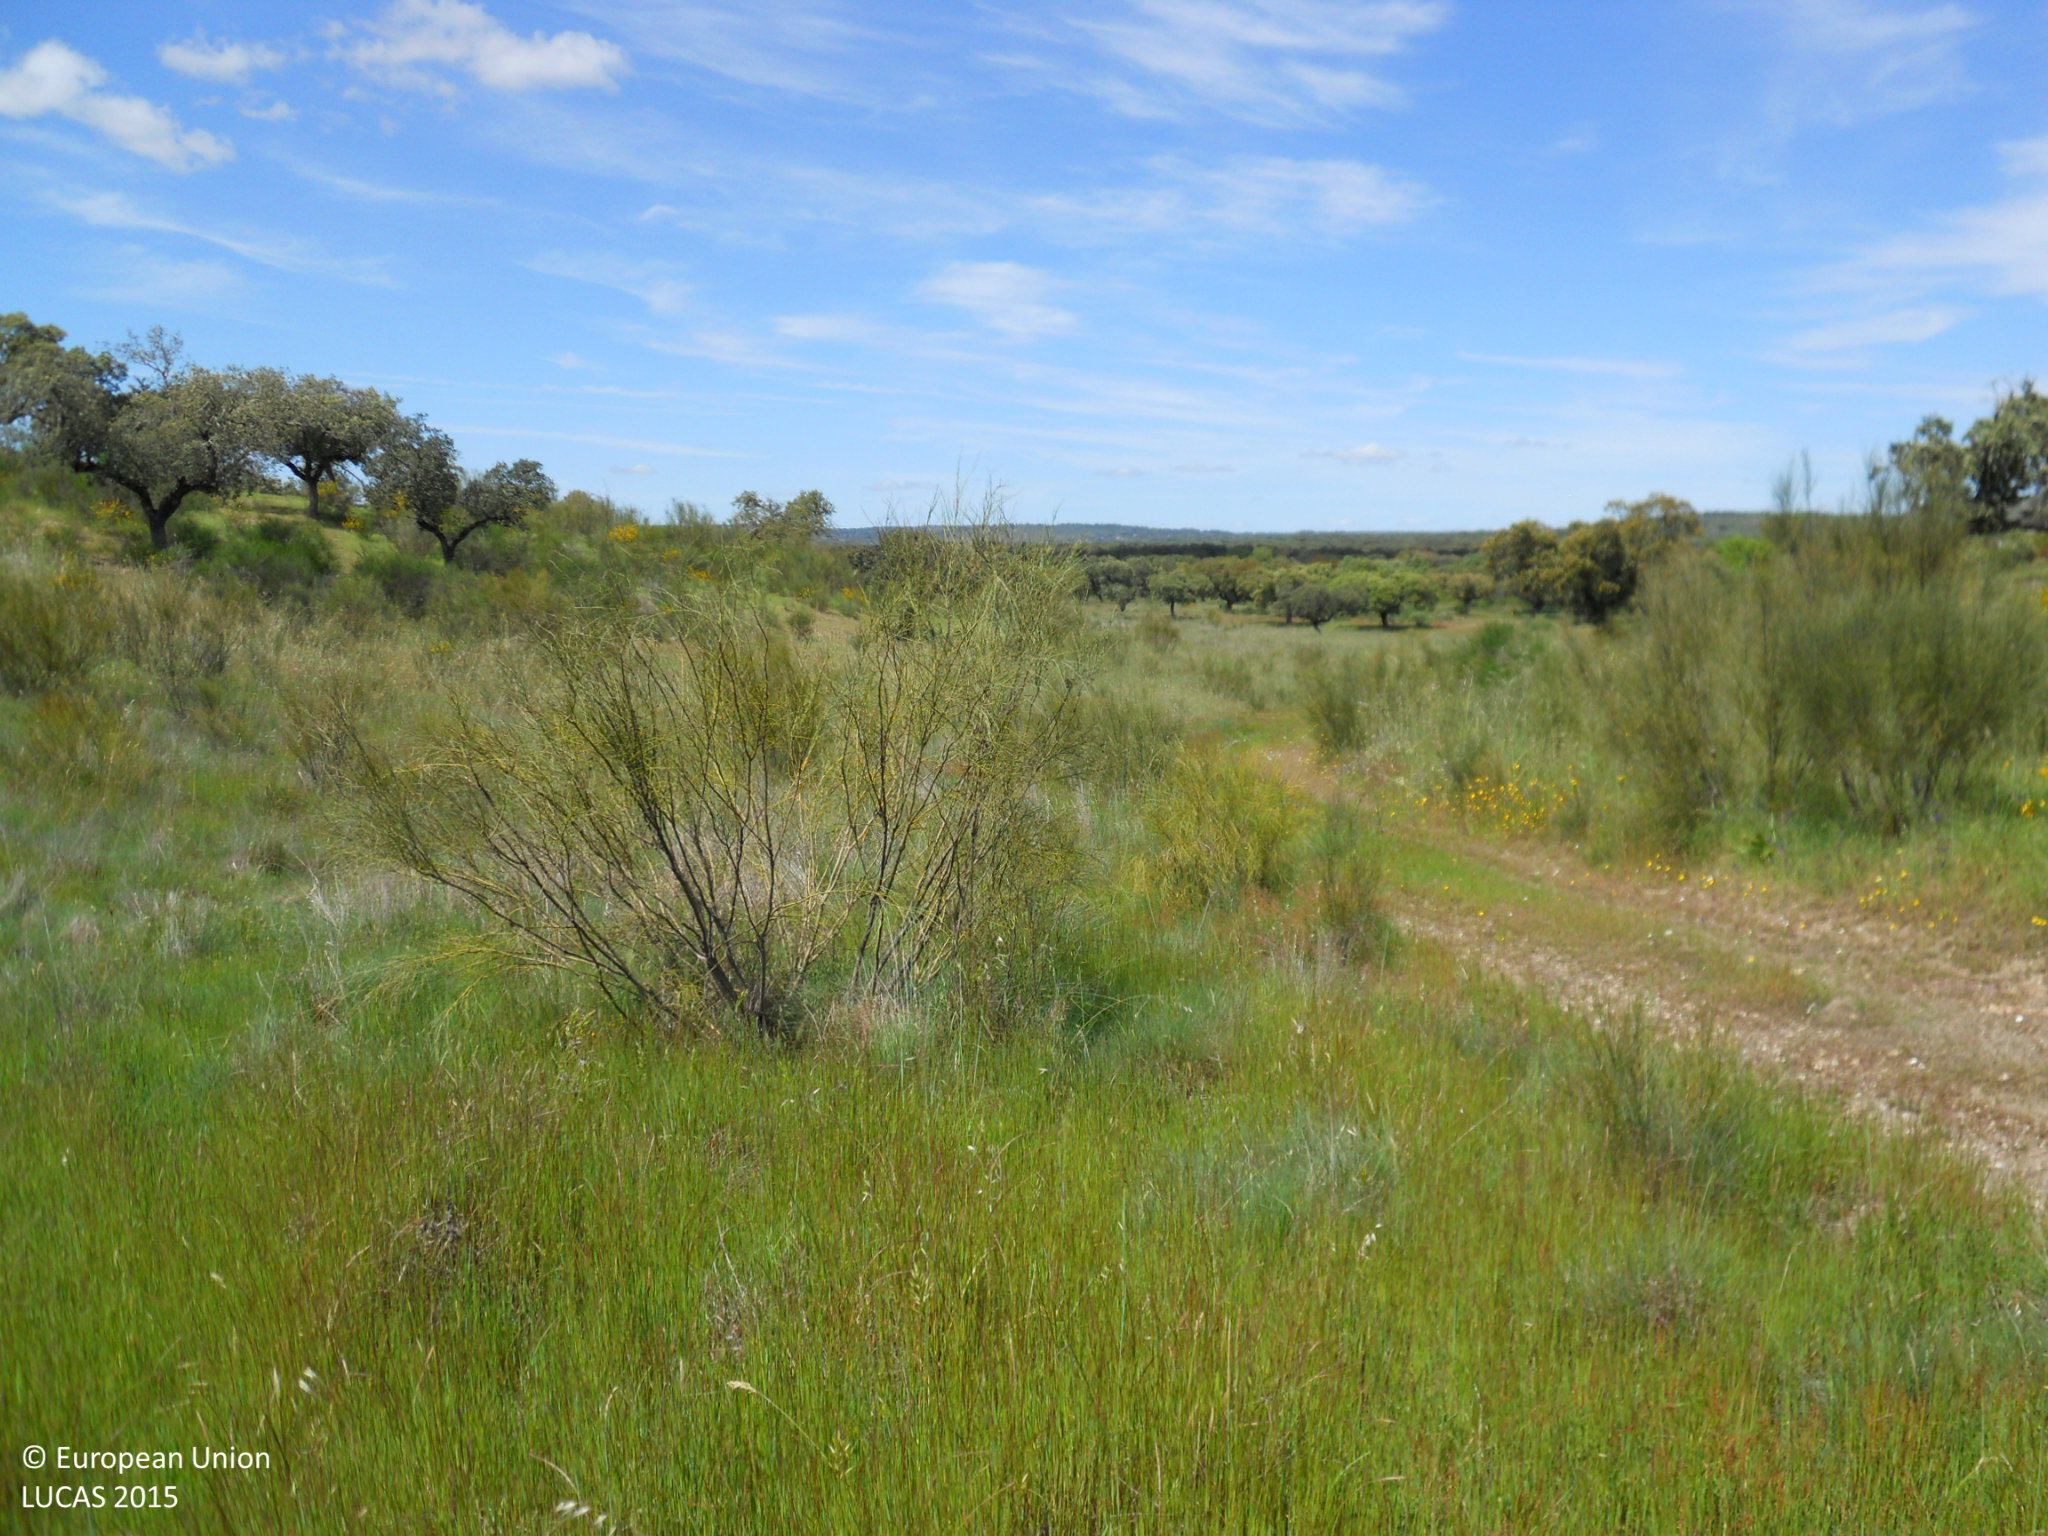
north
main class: Grassland
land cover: Grassland without tree/shrub cover
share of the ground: > 75 %
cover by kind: herbaceous plants 95 %, shrubs 5 %
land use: Agriculture (excluding fallow land and kitchen gardens)
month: April
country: ES
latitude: 39.2688
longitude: -7.1066
